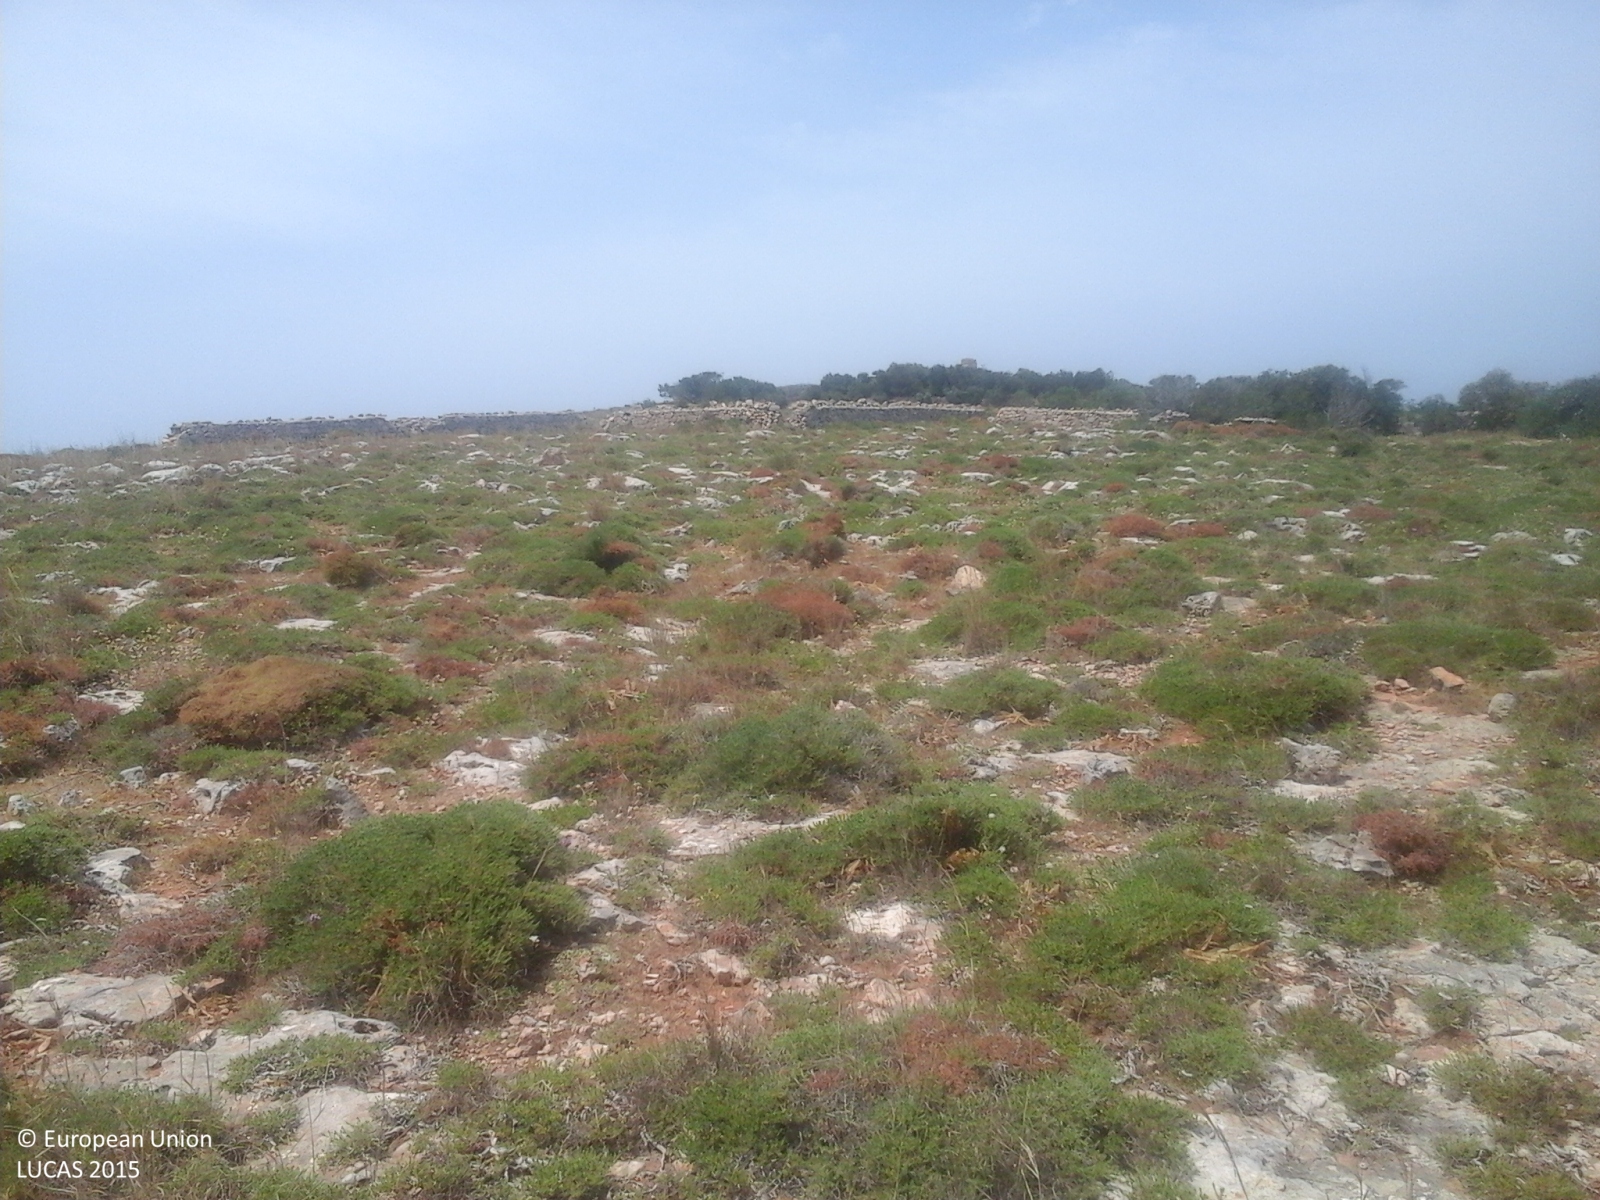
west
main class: Shrubland
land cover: Shrubland without tree cover
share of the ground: 50 - 75 %
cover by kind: consolidated bare surface 55 %, shrubs 35 %, herbaceous plants 10 %
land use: Semi-natural and natural areas not in use
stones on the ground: > 50 %
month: May
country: MT
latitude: 35.9744
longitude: 14.3407
